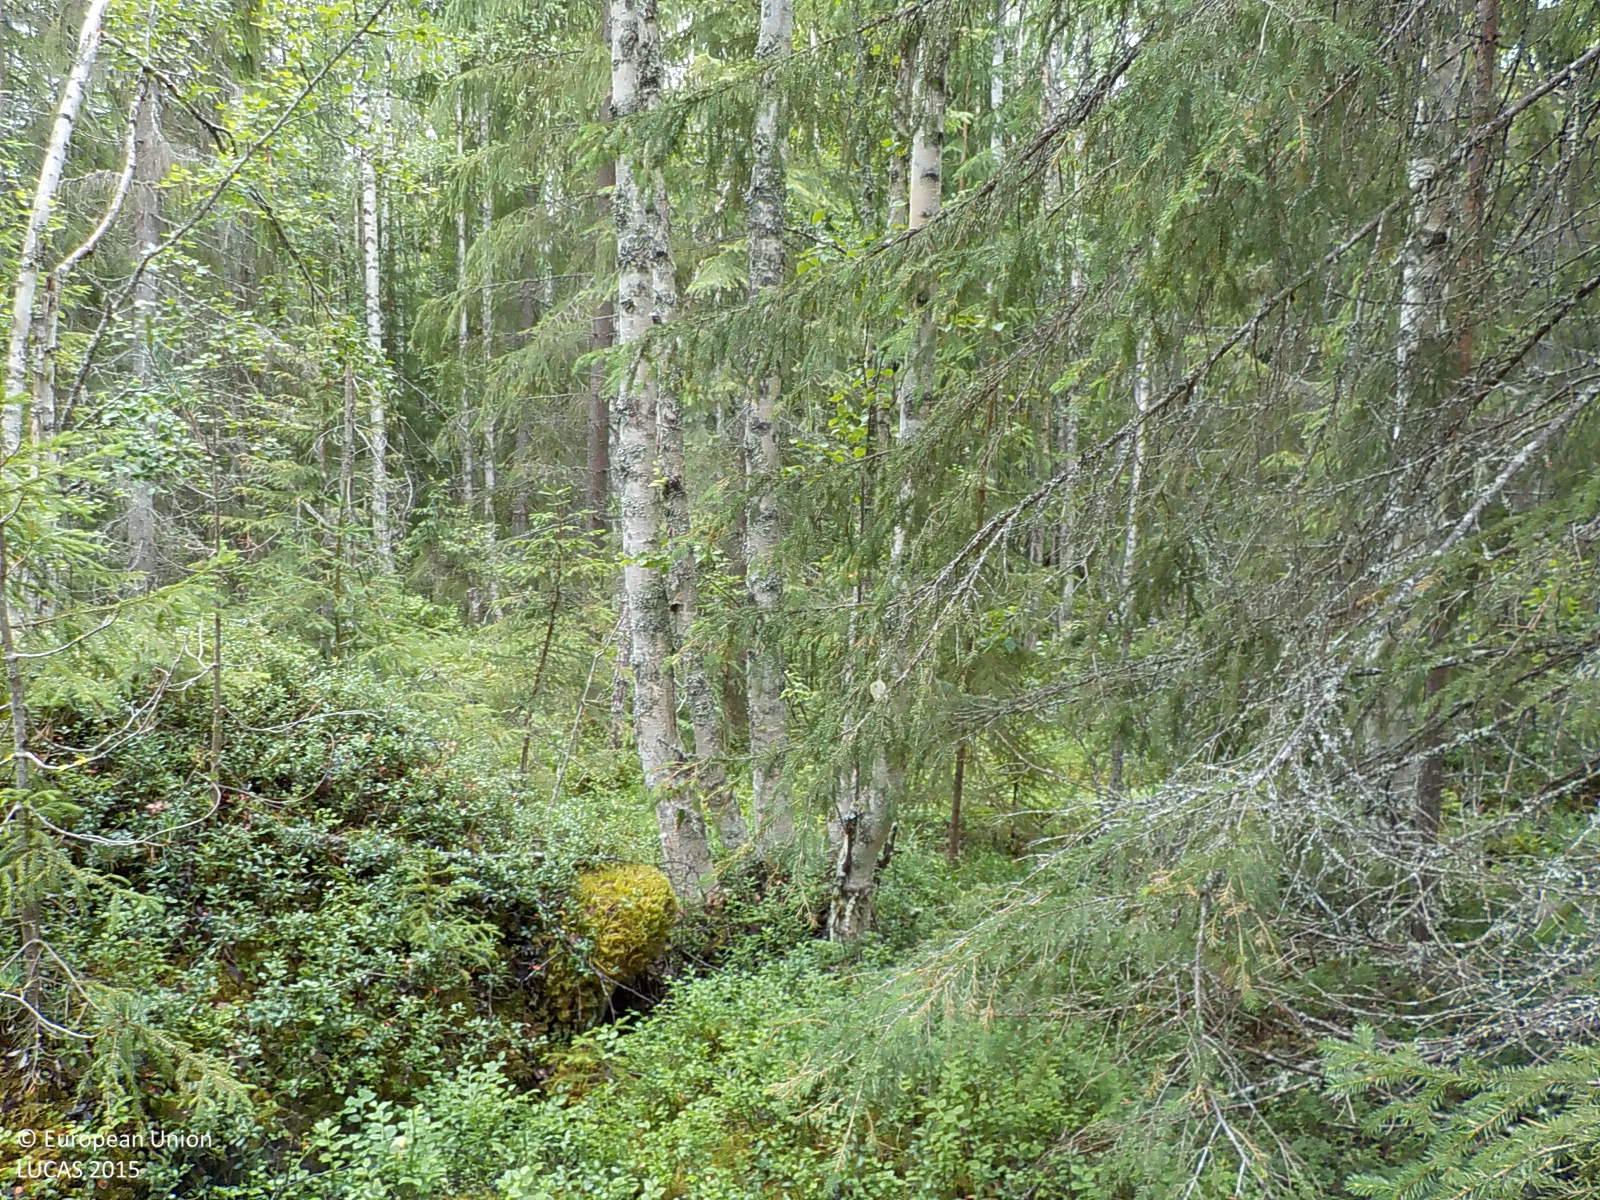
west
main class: Woodland
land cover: Other mixed woodland
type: boreal forest
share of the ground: > 75 %
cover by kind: coniferous forest trees 50 %, broadleaved forest trees 30 %, shrubs 10 %, lichens and mosses 5 %, consolidated bare surface 5 %
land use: Forestry
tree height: > 5 m
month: July
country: SE
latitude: 63.3430
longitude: 17.2668
